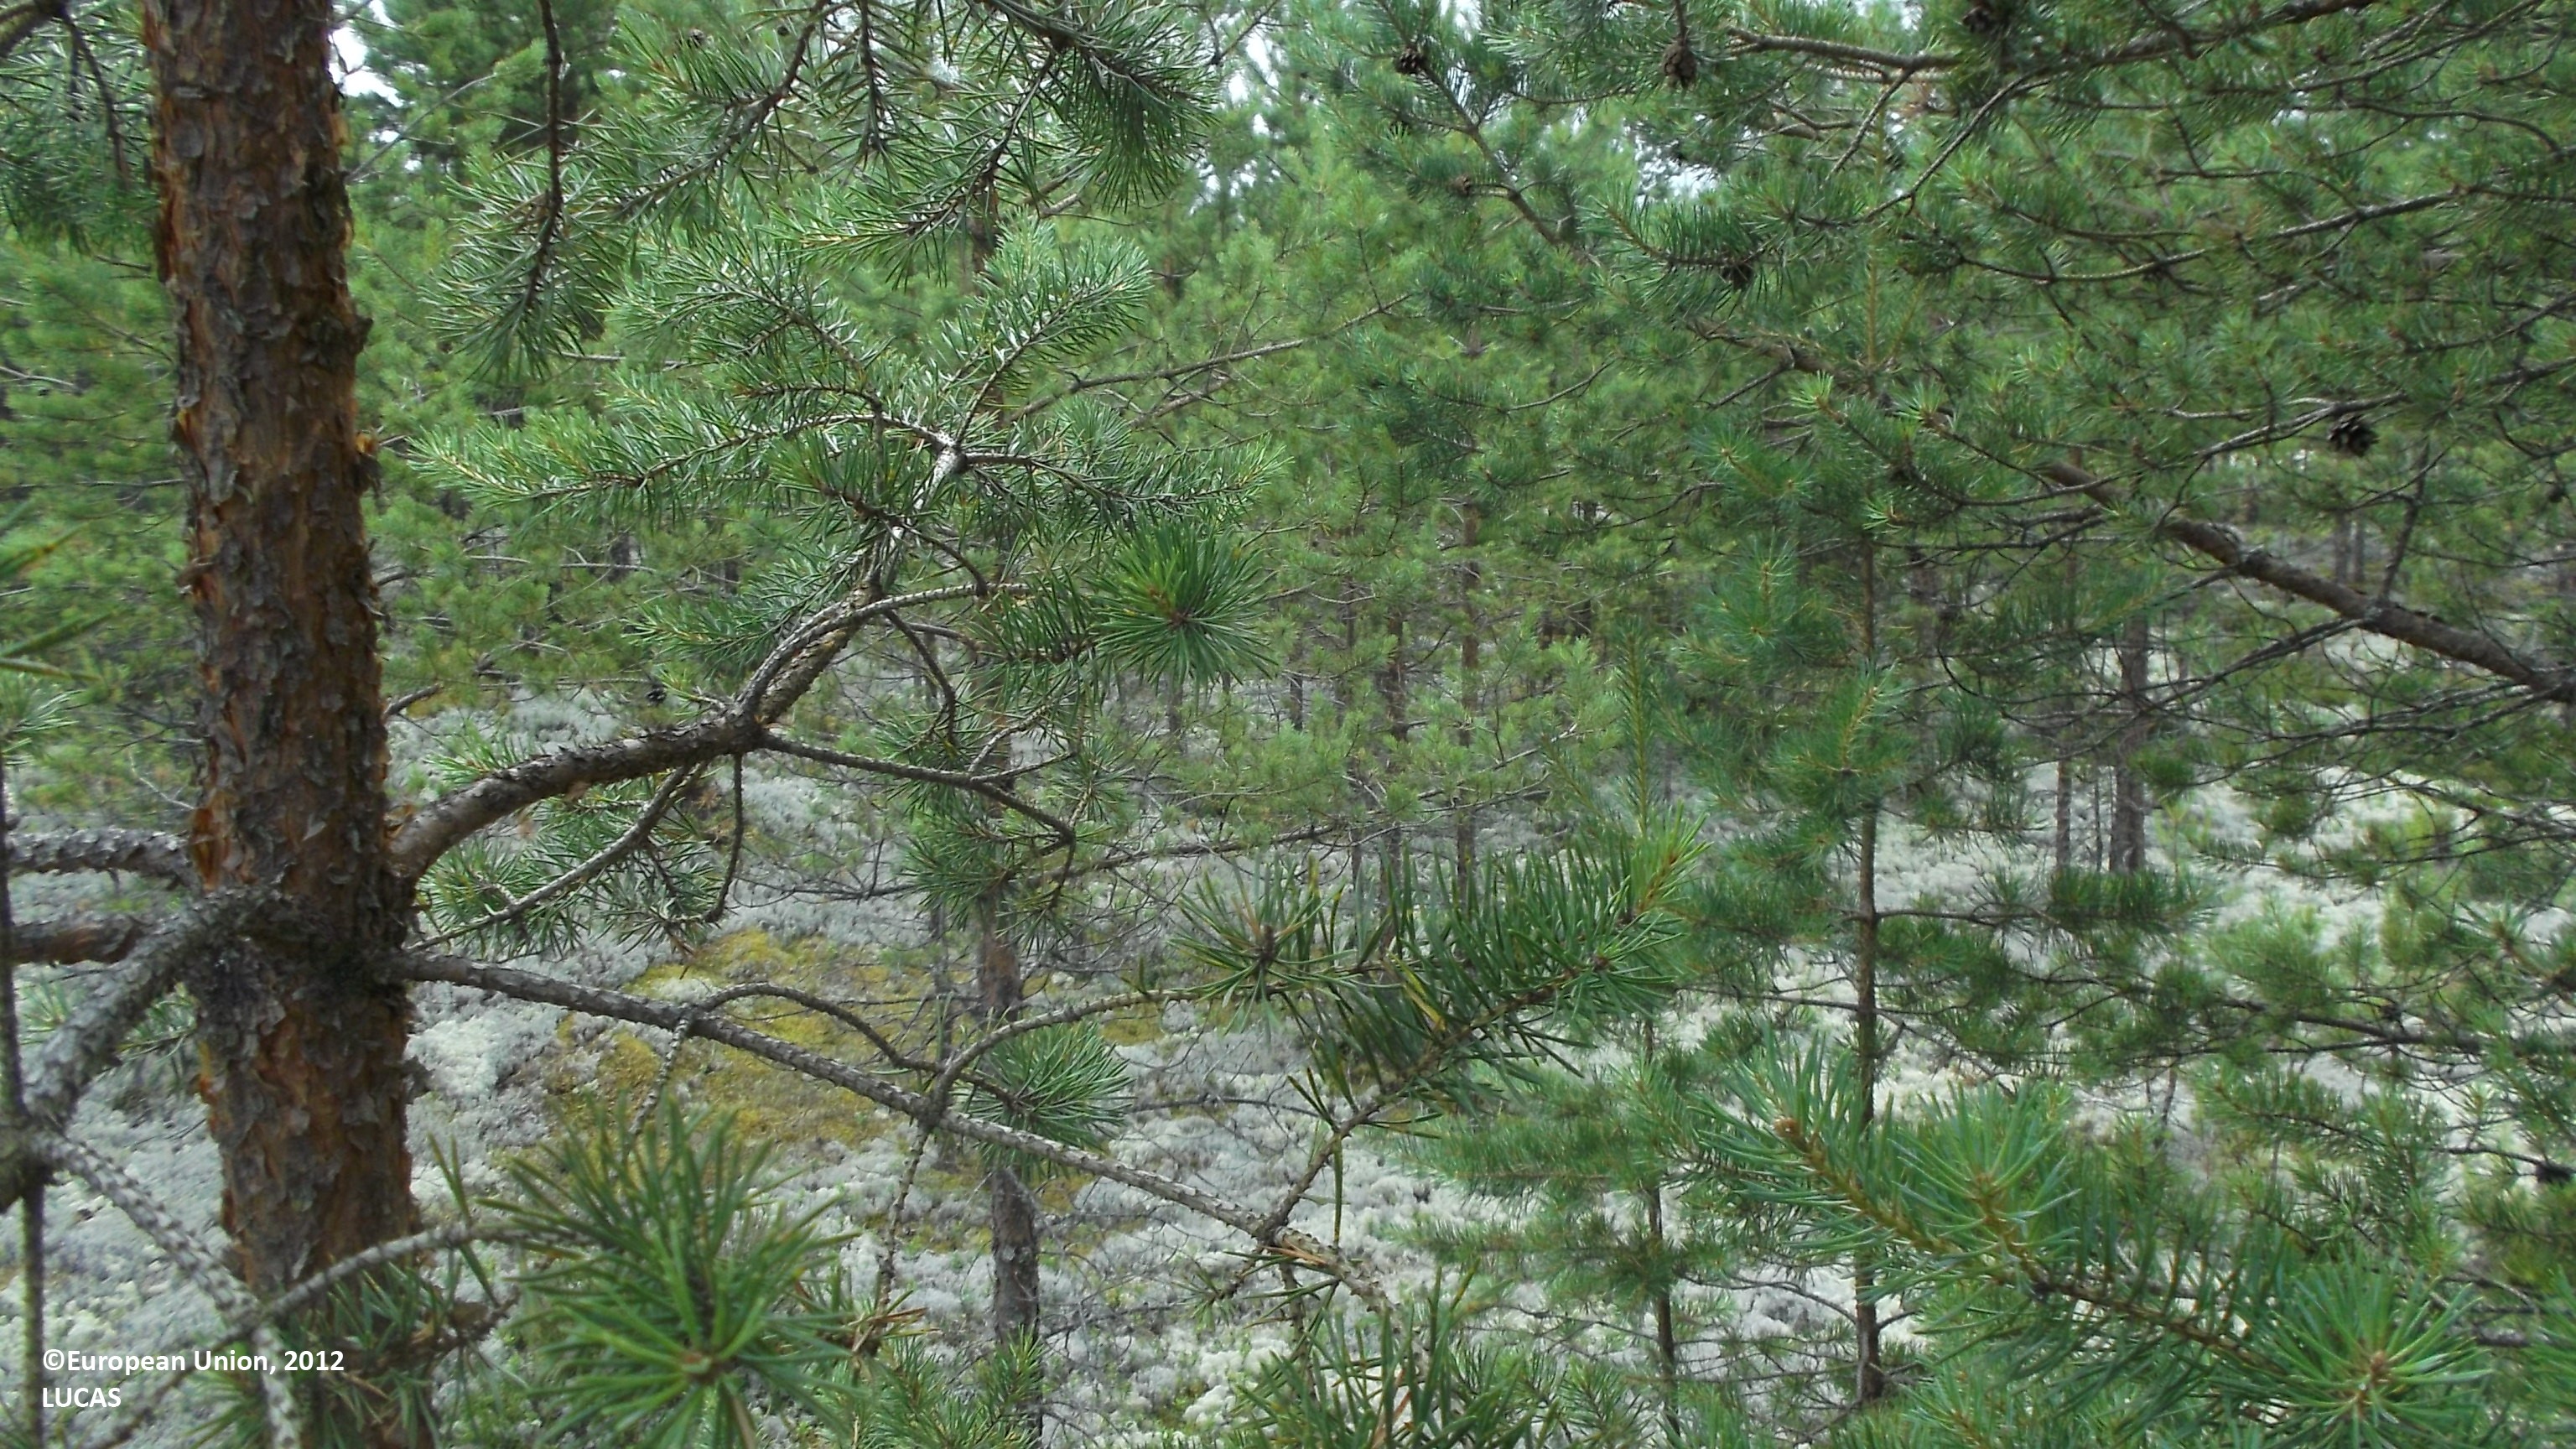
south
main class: Woodland
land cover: Pine dominated coniferous woodland
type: boreal forest
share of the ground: 25 - 50 %
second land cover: Lichens and moss
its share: 50 - 75 %
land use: Forestry
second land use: Semi-natural and natural areas not in use
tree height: > 5 m
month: July
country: FI
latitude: 63.9815
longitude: 23.5224
